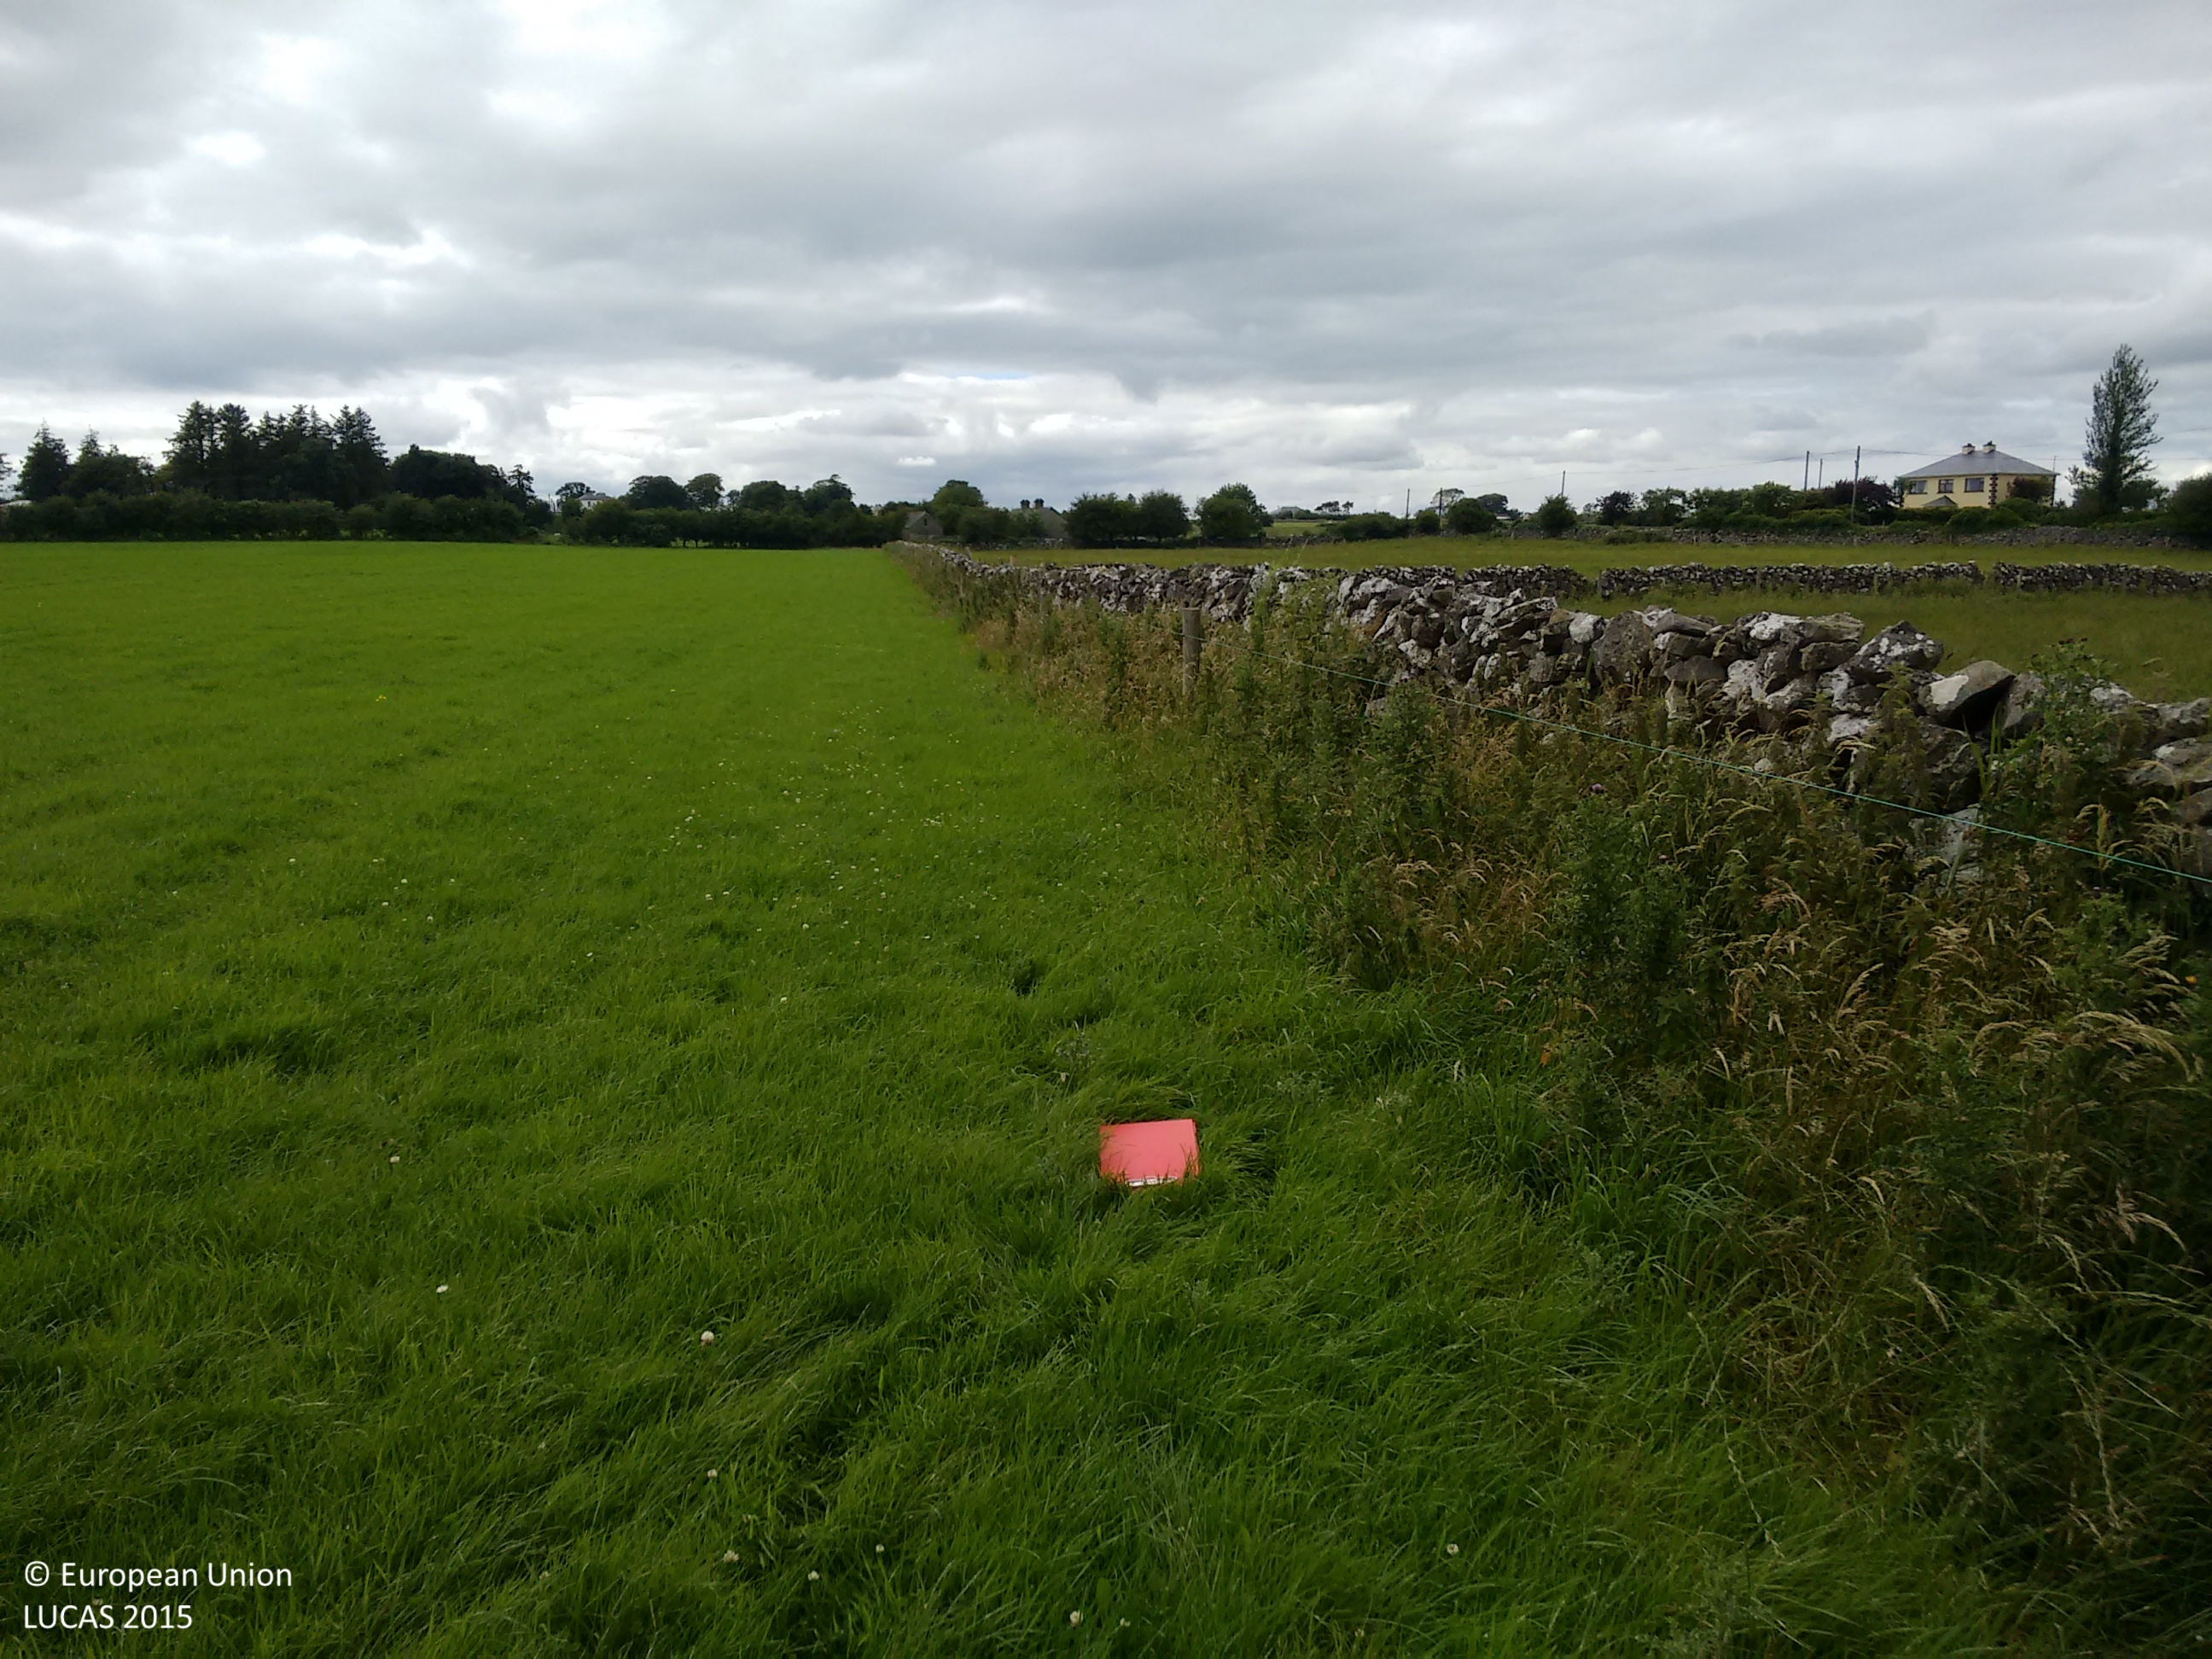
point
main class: Grassland
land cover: Grassland without tree/shrub cover
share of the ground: > 75 %
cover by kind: herbaceous plants 100 %
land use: Agriculture (excluding fallow land and kitchen gardens)
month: July
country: IE
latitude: 53.6413
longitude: -9.0771
